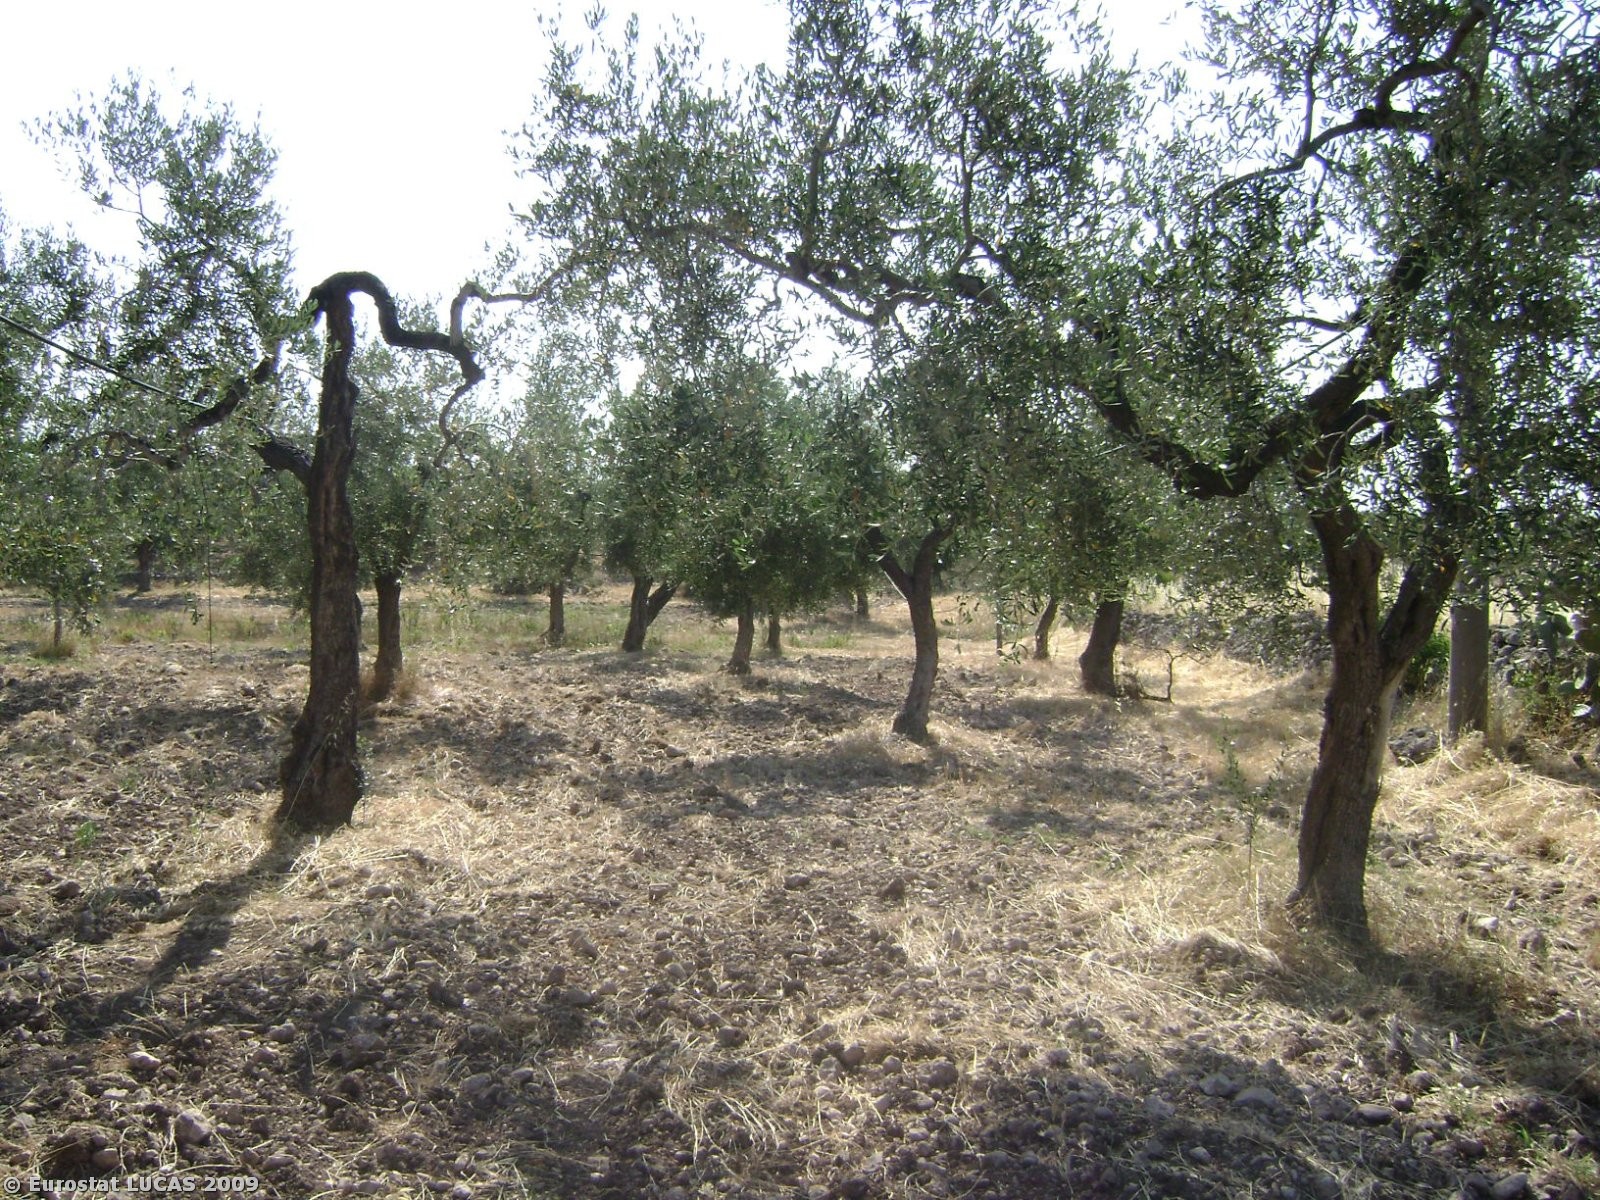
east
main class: Cropland
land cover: Olive groves
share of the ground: 50 - 75 %
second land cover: Bare land
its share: < 10 %
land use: Agriculture (excluding fallow land and kitchen gardens)
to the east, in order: Olive groves; Bare land; Grass margins; Ditches and canals; Olive groves; Bare land; Electric lines; Olive groves; Bare land; Dry stone walls
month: June
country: IT
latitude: 41.6488
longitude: 15.9019
